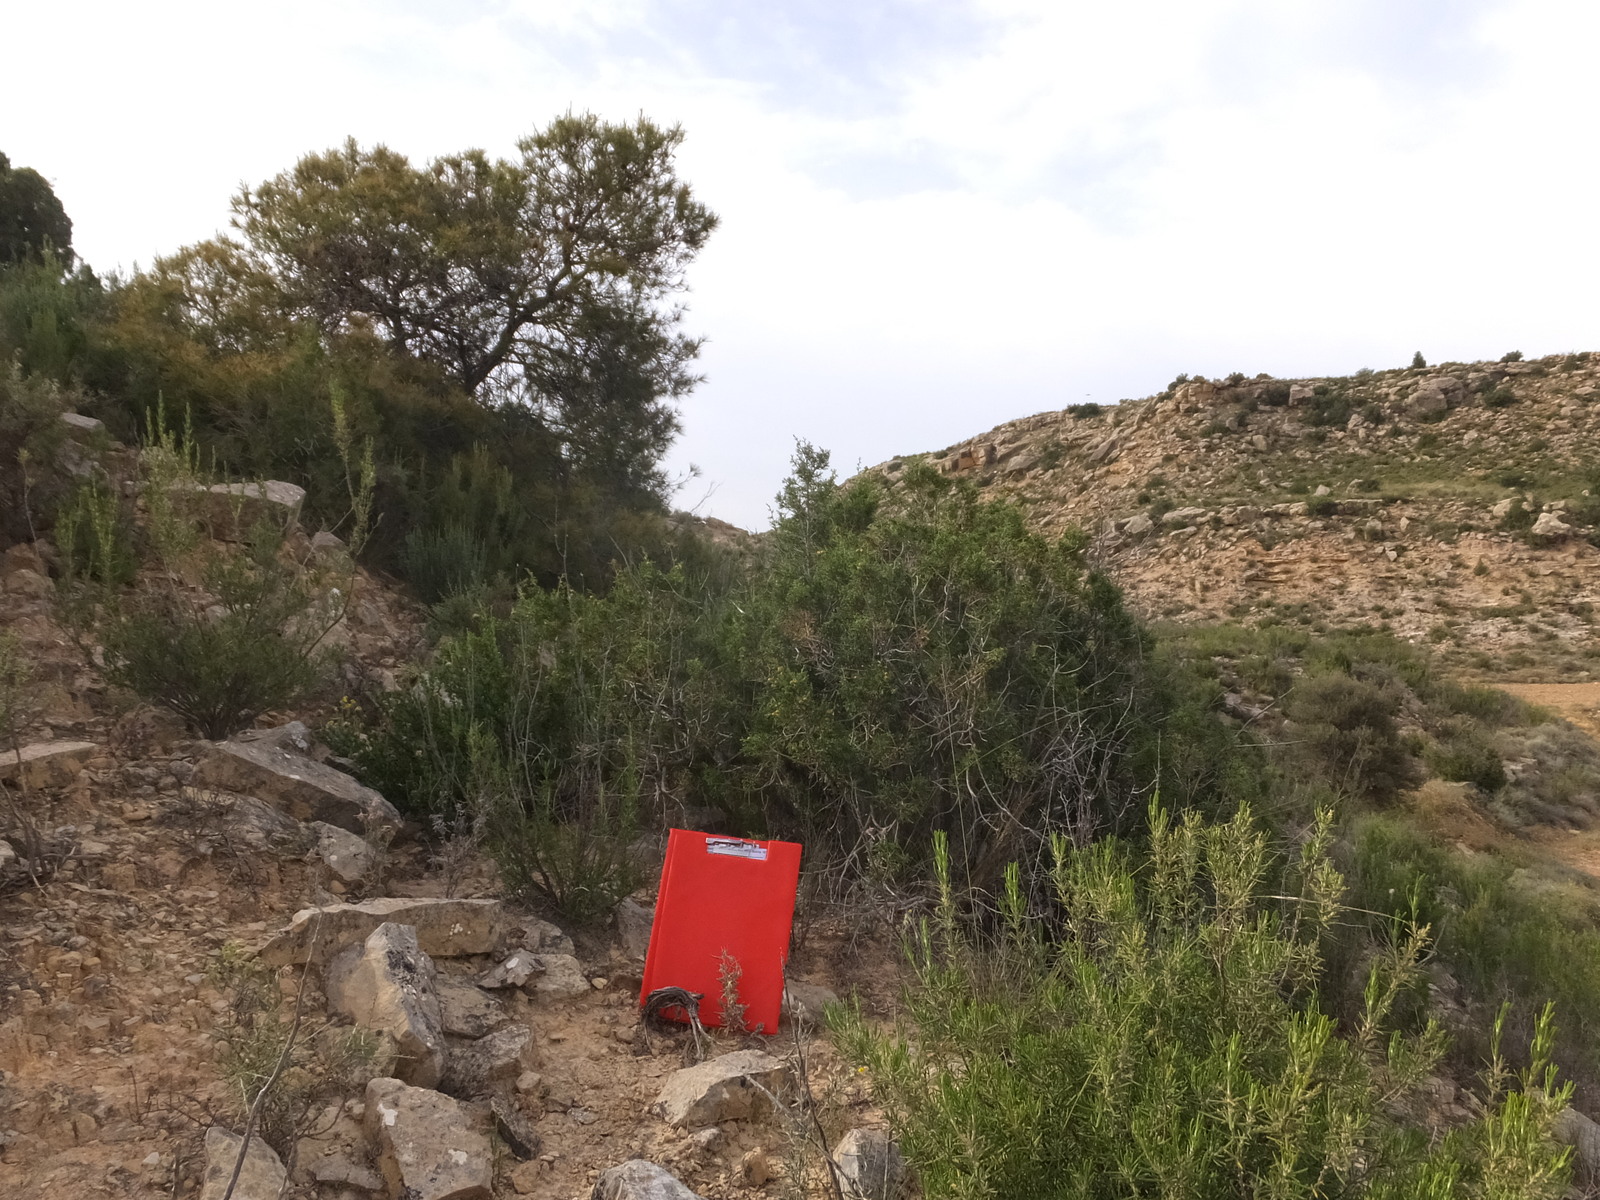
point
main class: Shrubland
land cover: Shrubland with sparse tree cover
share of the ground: > 75 %
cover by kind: shrubs 75 %, herbaceous plants 20 %, coniferous forest trees 5 %
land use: Semi-natural and natural areas not in use
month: May
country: ES
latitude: 41.3136
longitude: -0.2515
